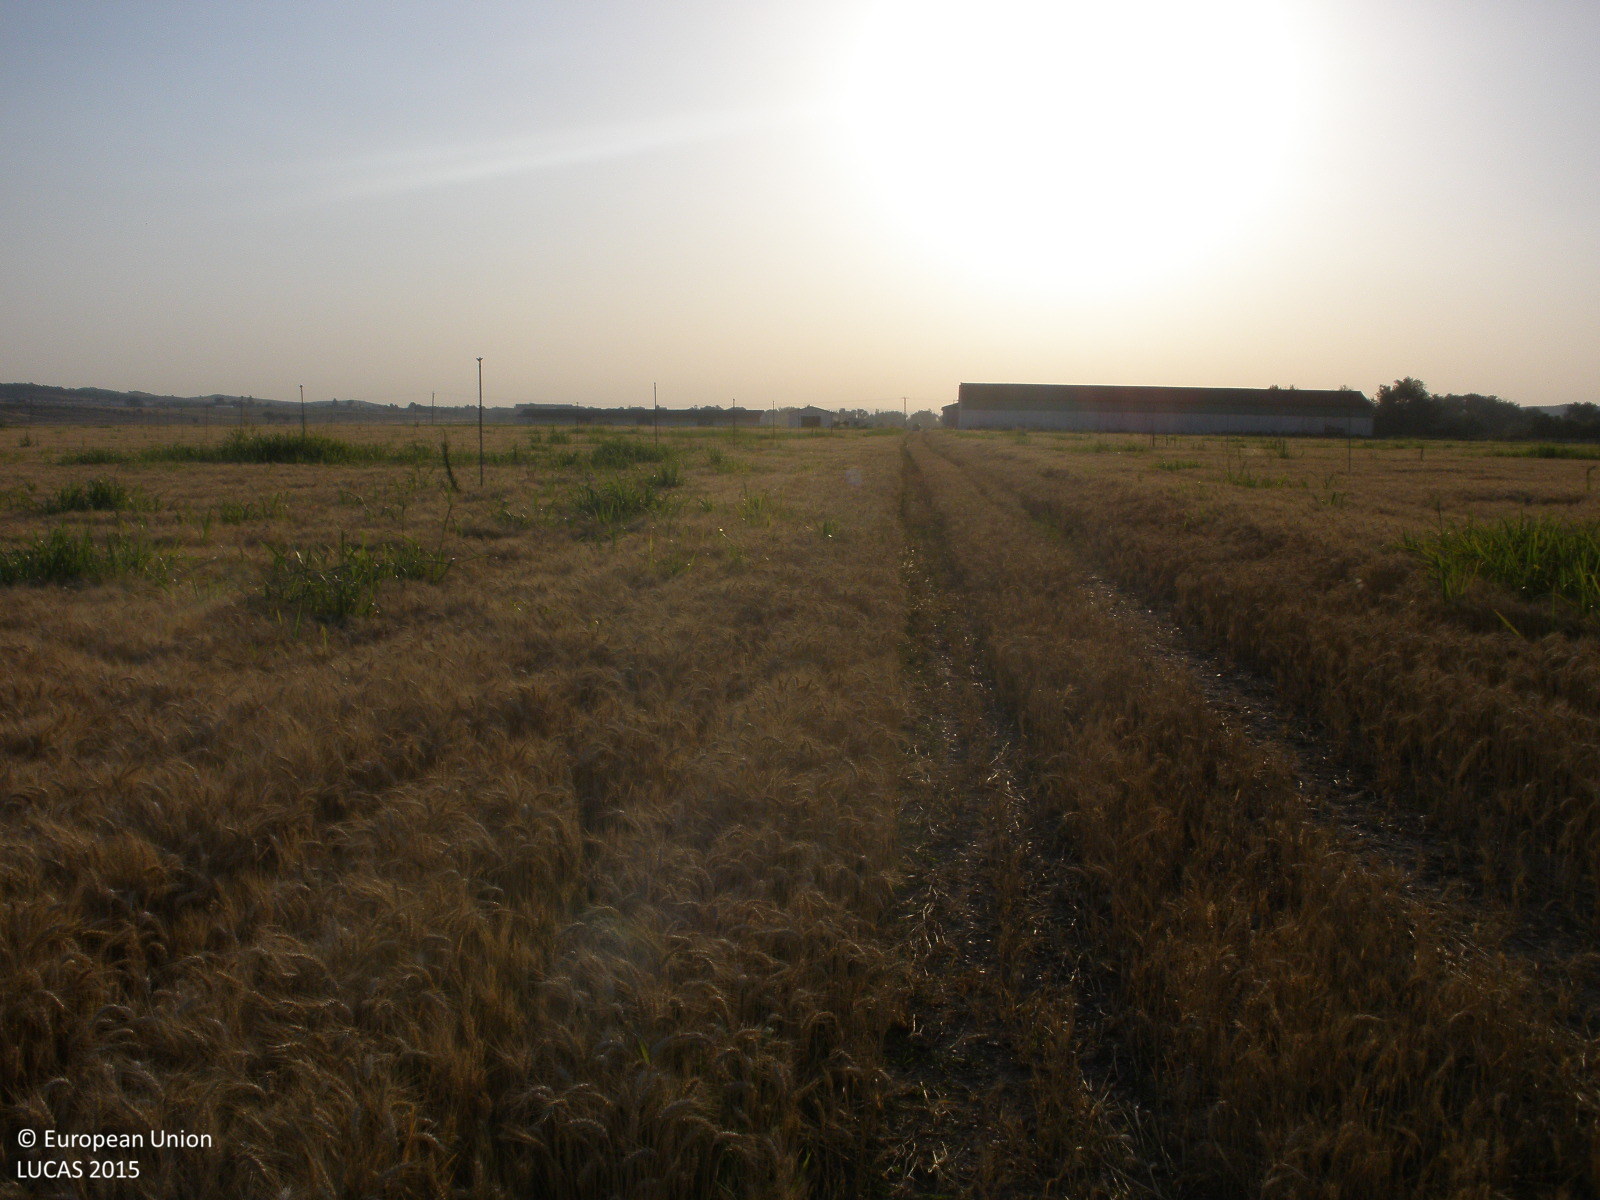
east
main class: Cropland
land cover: Common wheat
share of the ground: > 75 %
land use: Agriculture (excluding fallow land and kitchen gardens)
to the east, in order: Common wheat
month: June
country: ES
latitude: 40.0582
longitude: -3.2629
